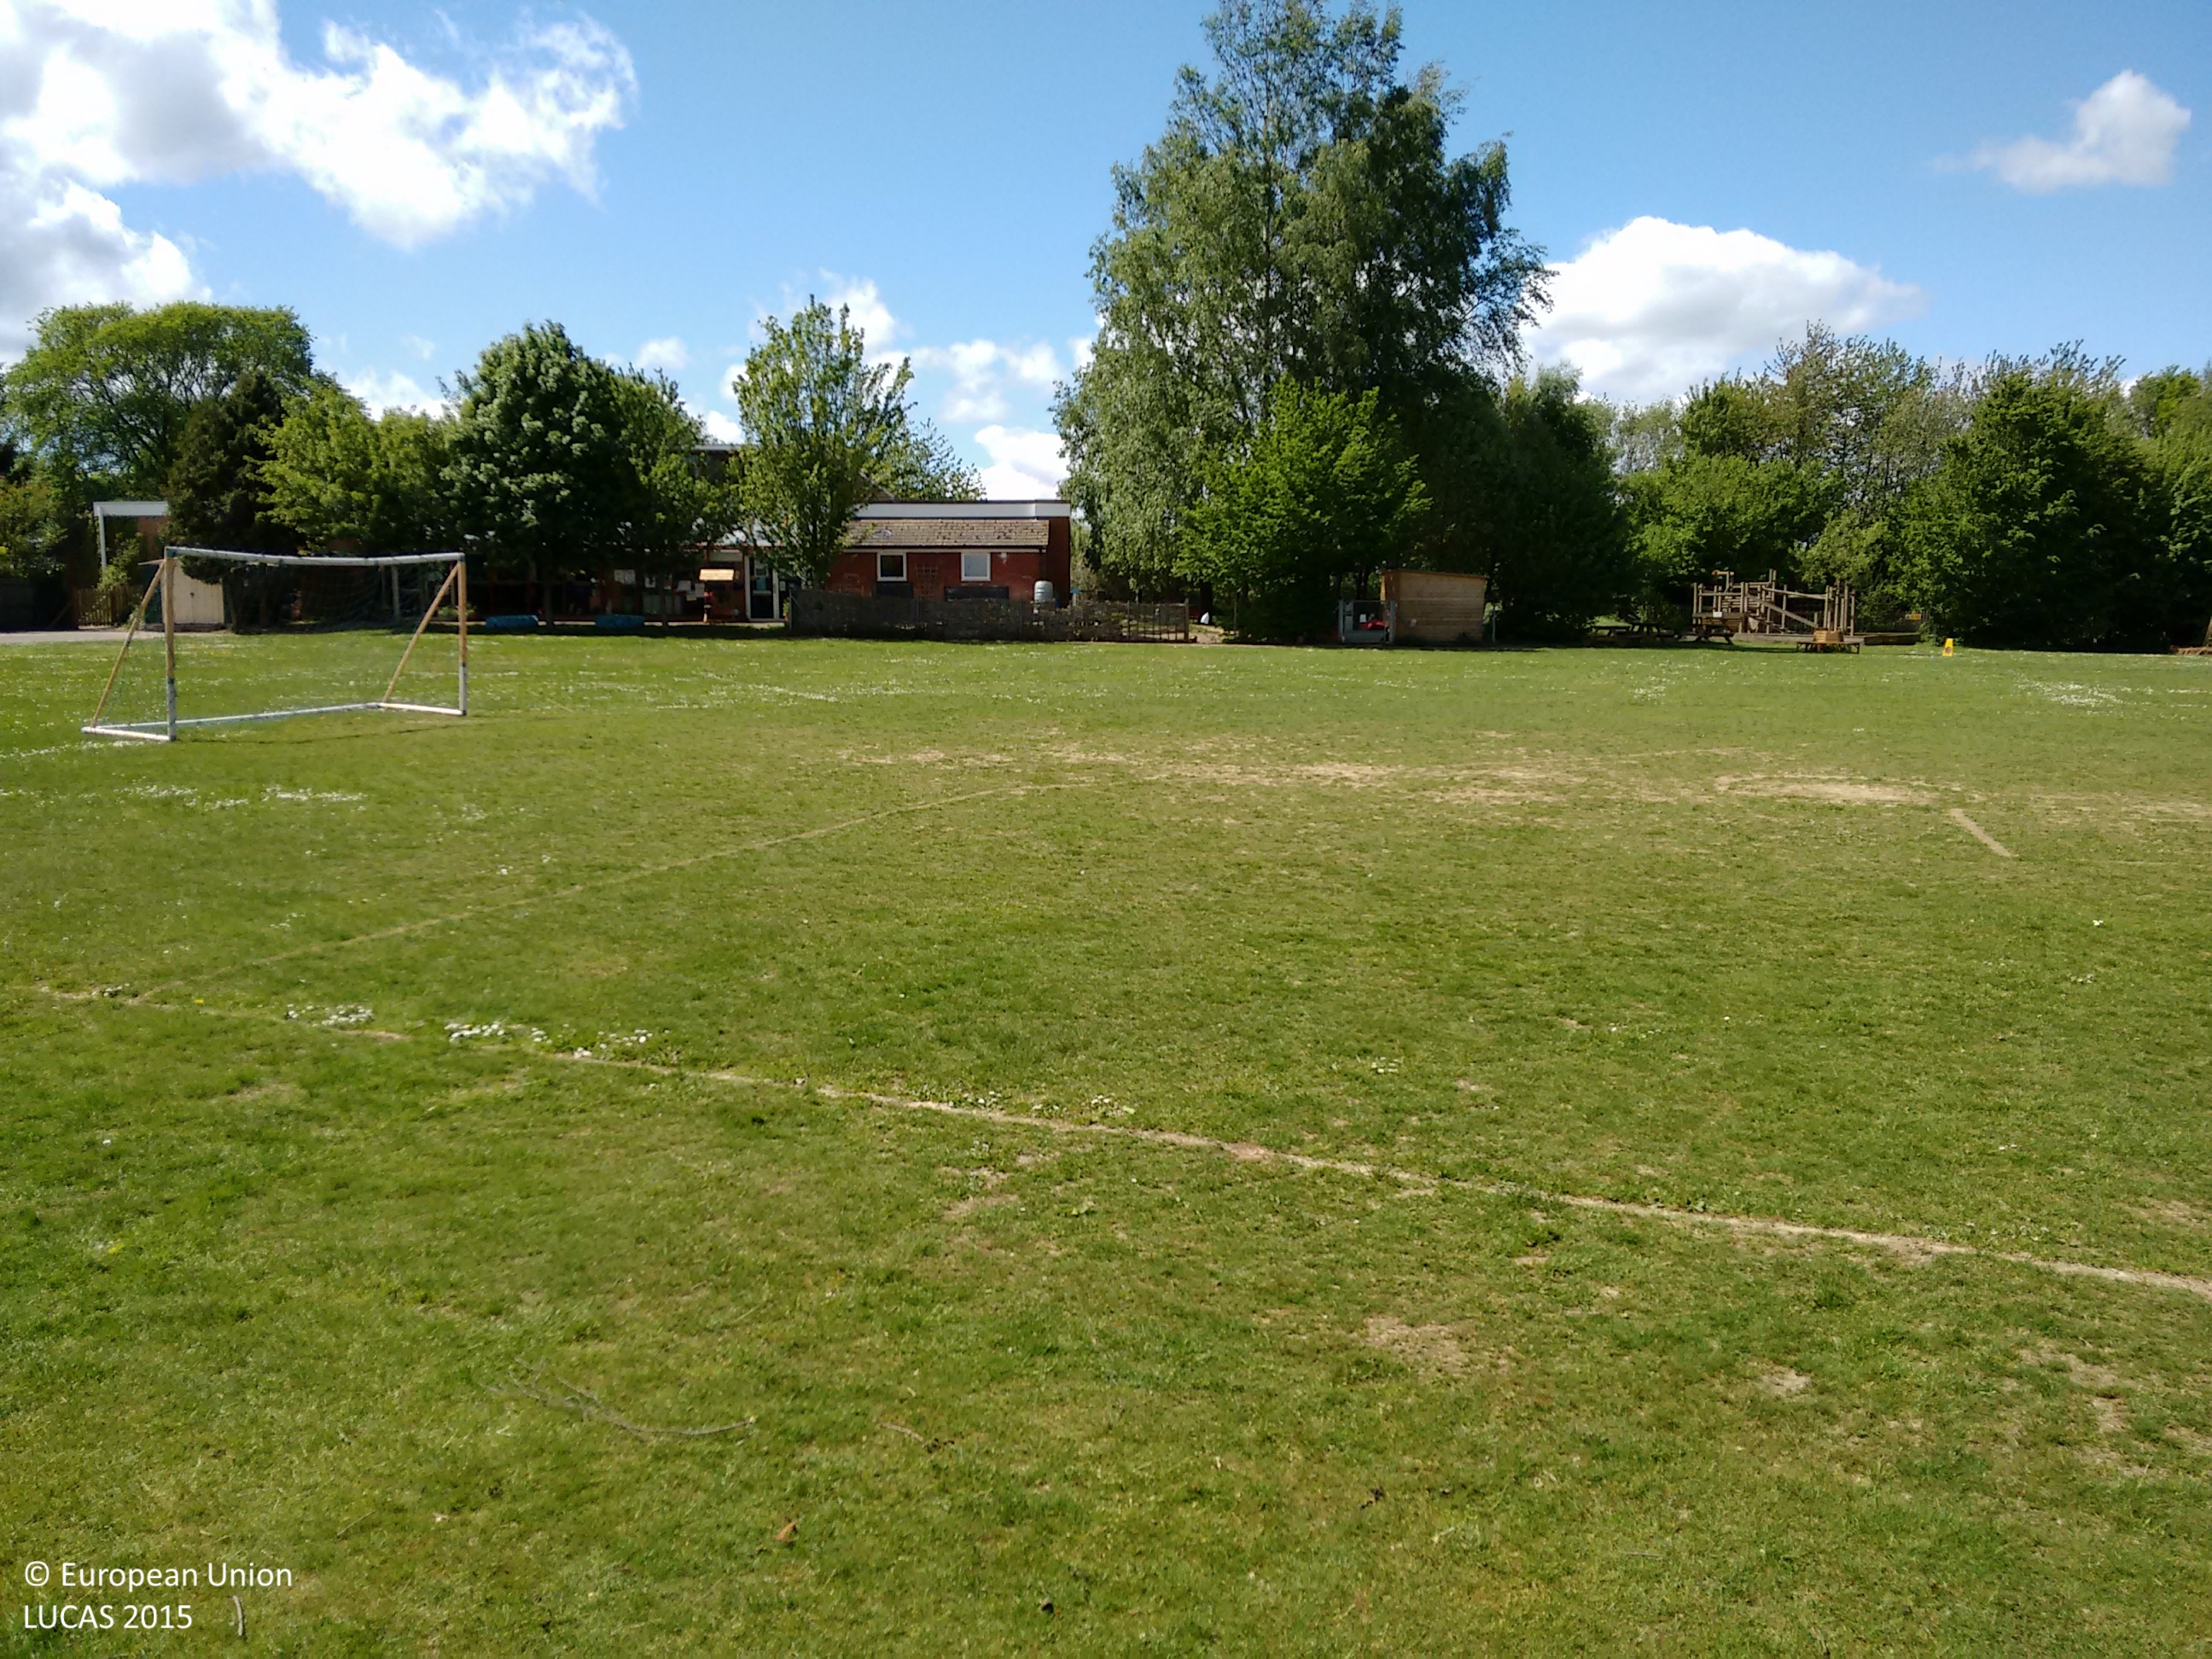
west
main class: Woodland
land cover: Broadleaved woodland
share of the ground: > 75 %
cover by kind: broadleaved forest trees 85 %, shrubs 15 %
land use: Residential
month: May
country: GB
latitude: 51.3549
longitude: -1.2047
